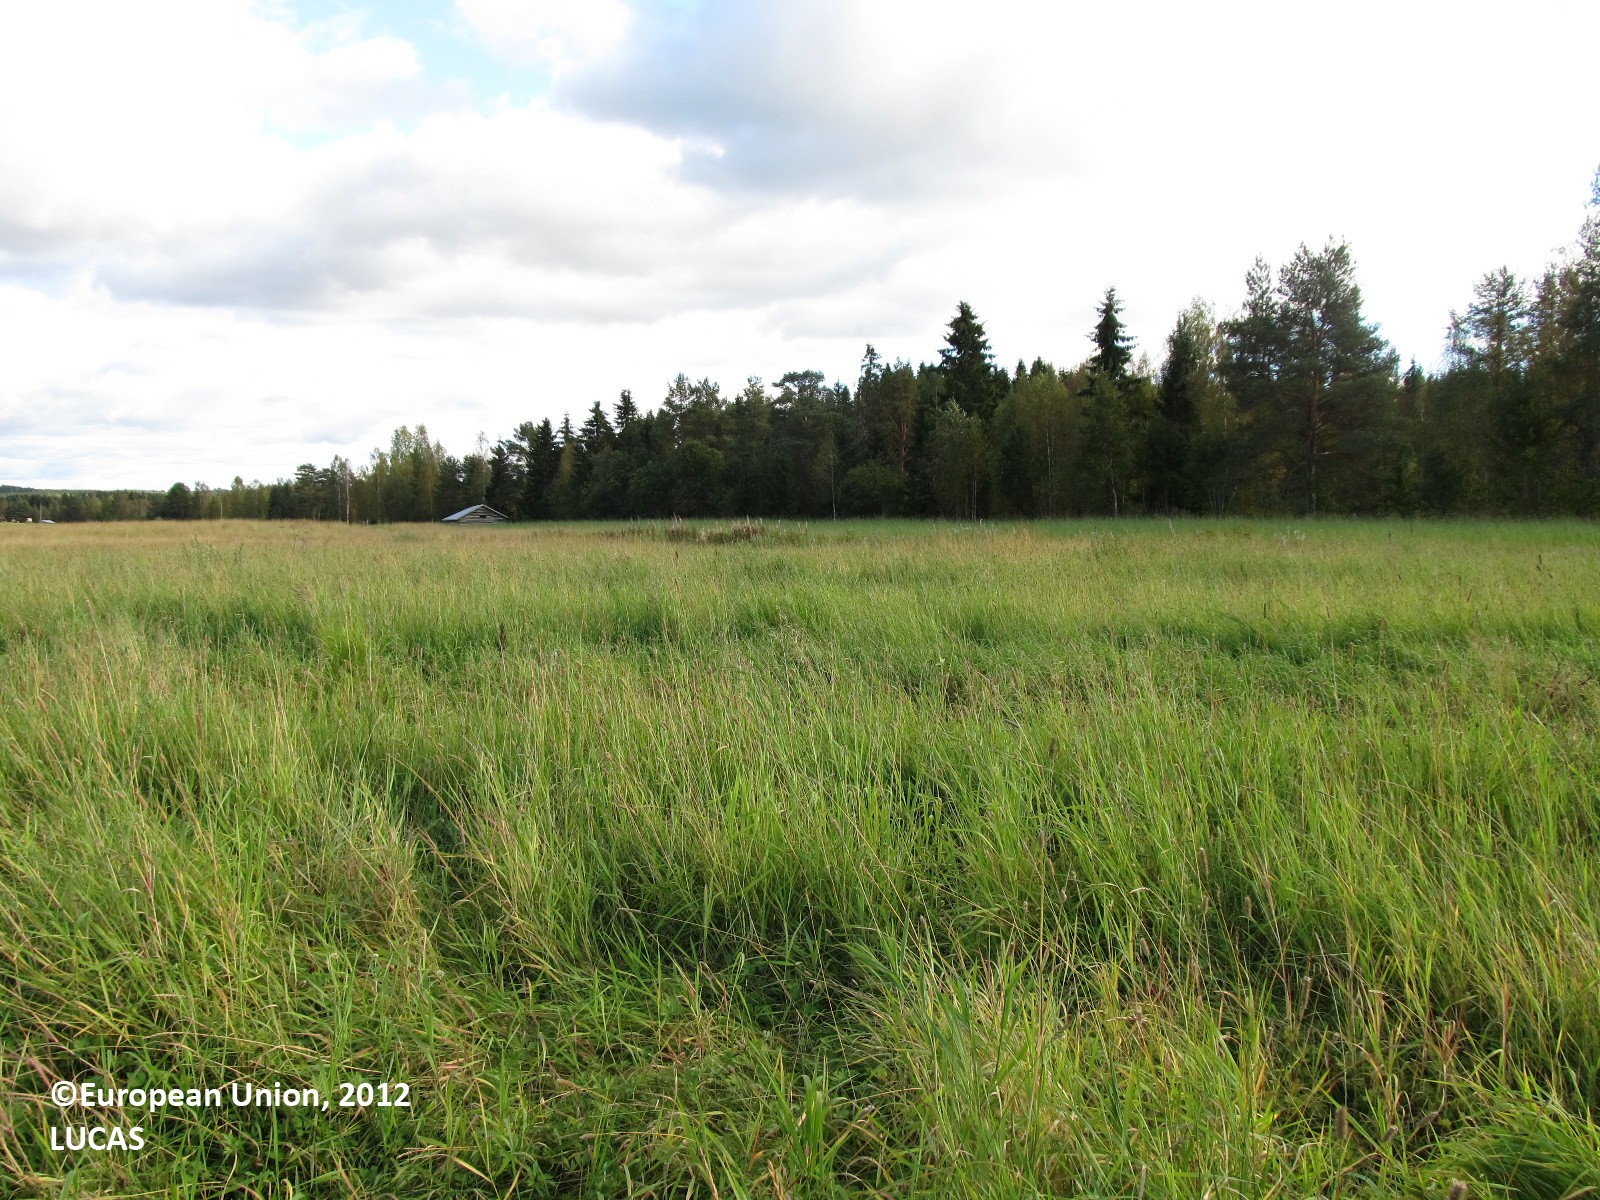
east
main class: Cropland
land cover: Temporary grasslands
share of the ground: > 75 %
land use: Agriculture (excluding fallow land and kitchen gardens)
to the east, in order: Temporary grasslands; Ditches and canals; Temporary grasslands; Ditches and canals; Fences; Temporary grasslands; Ditches and canals; Spruce dominated coniferous woodland
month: September
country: FI
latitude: 63.2711
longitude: 28.3828
